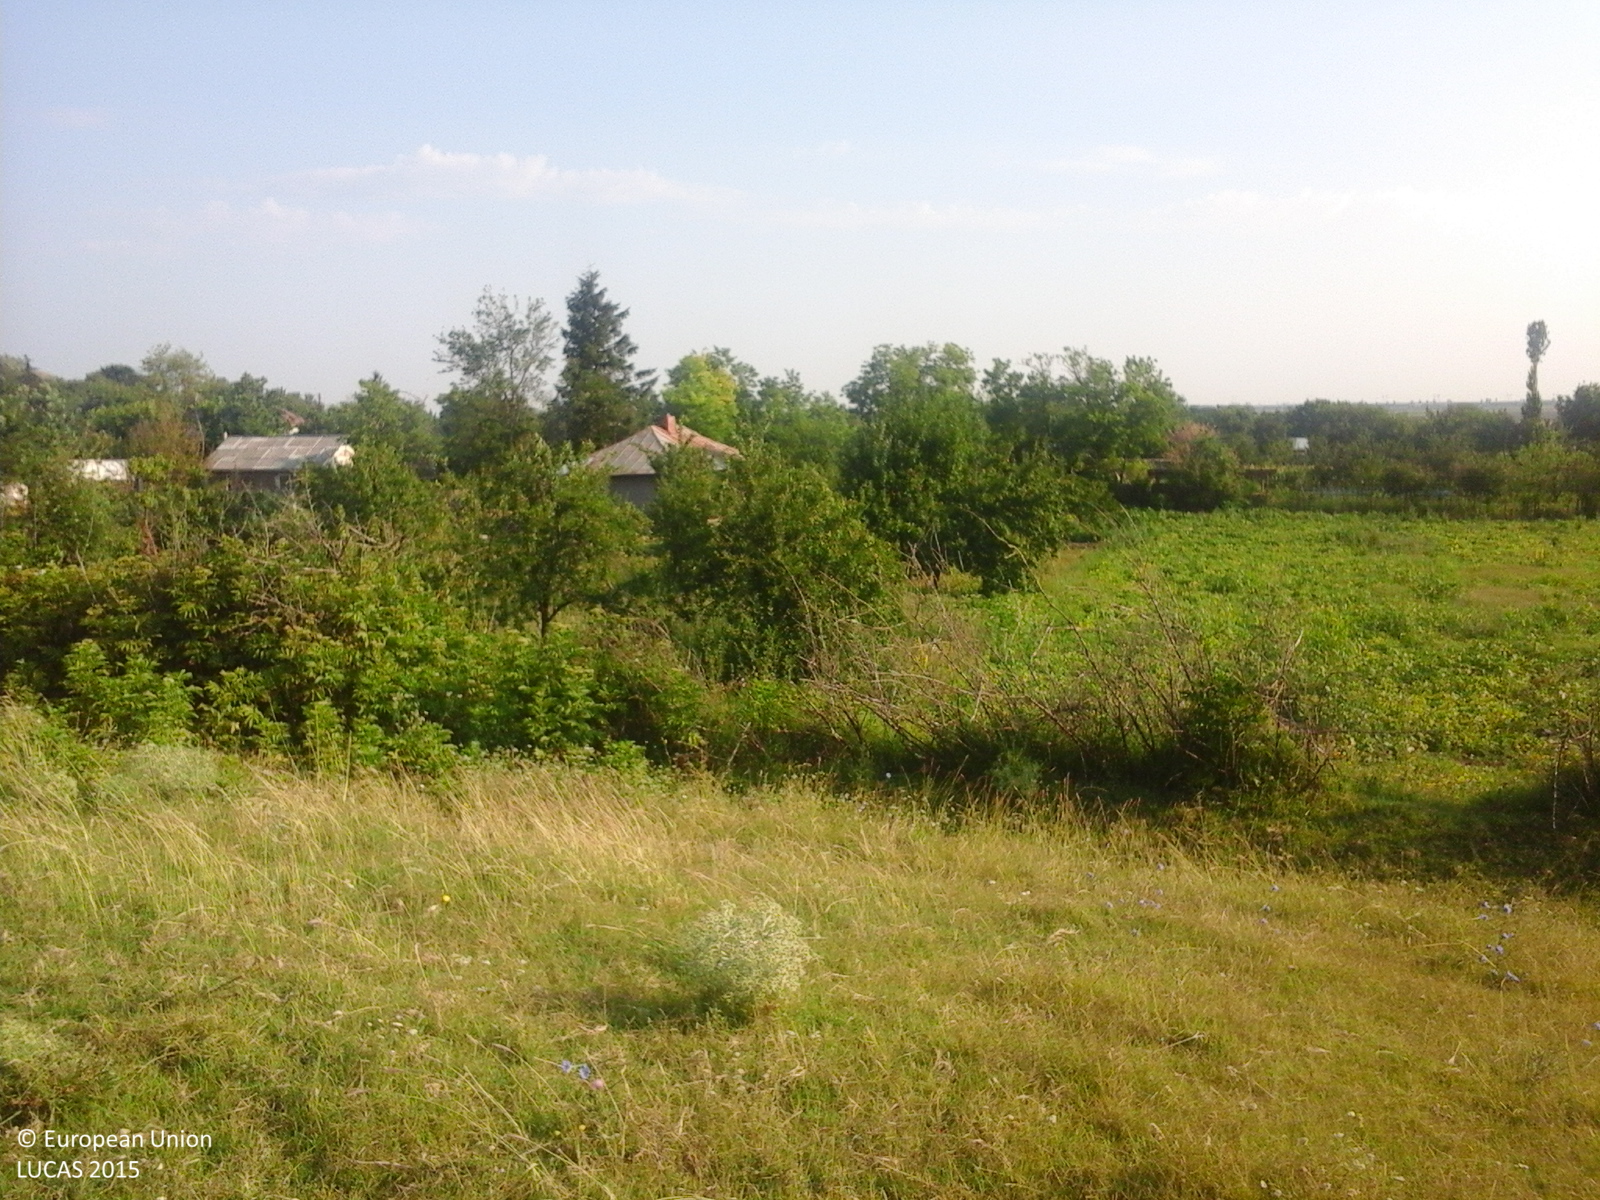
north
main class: Grassland
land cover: Grassland without tree/shrub cover
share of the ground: > 75 %
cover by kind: herbaceous plants 100 %
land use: Agriculture (excluding fallow land and kitchen gardens)
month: July
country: RO
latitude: 44.5445
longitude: 27.0599
